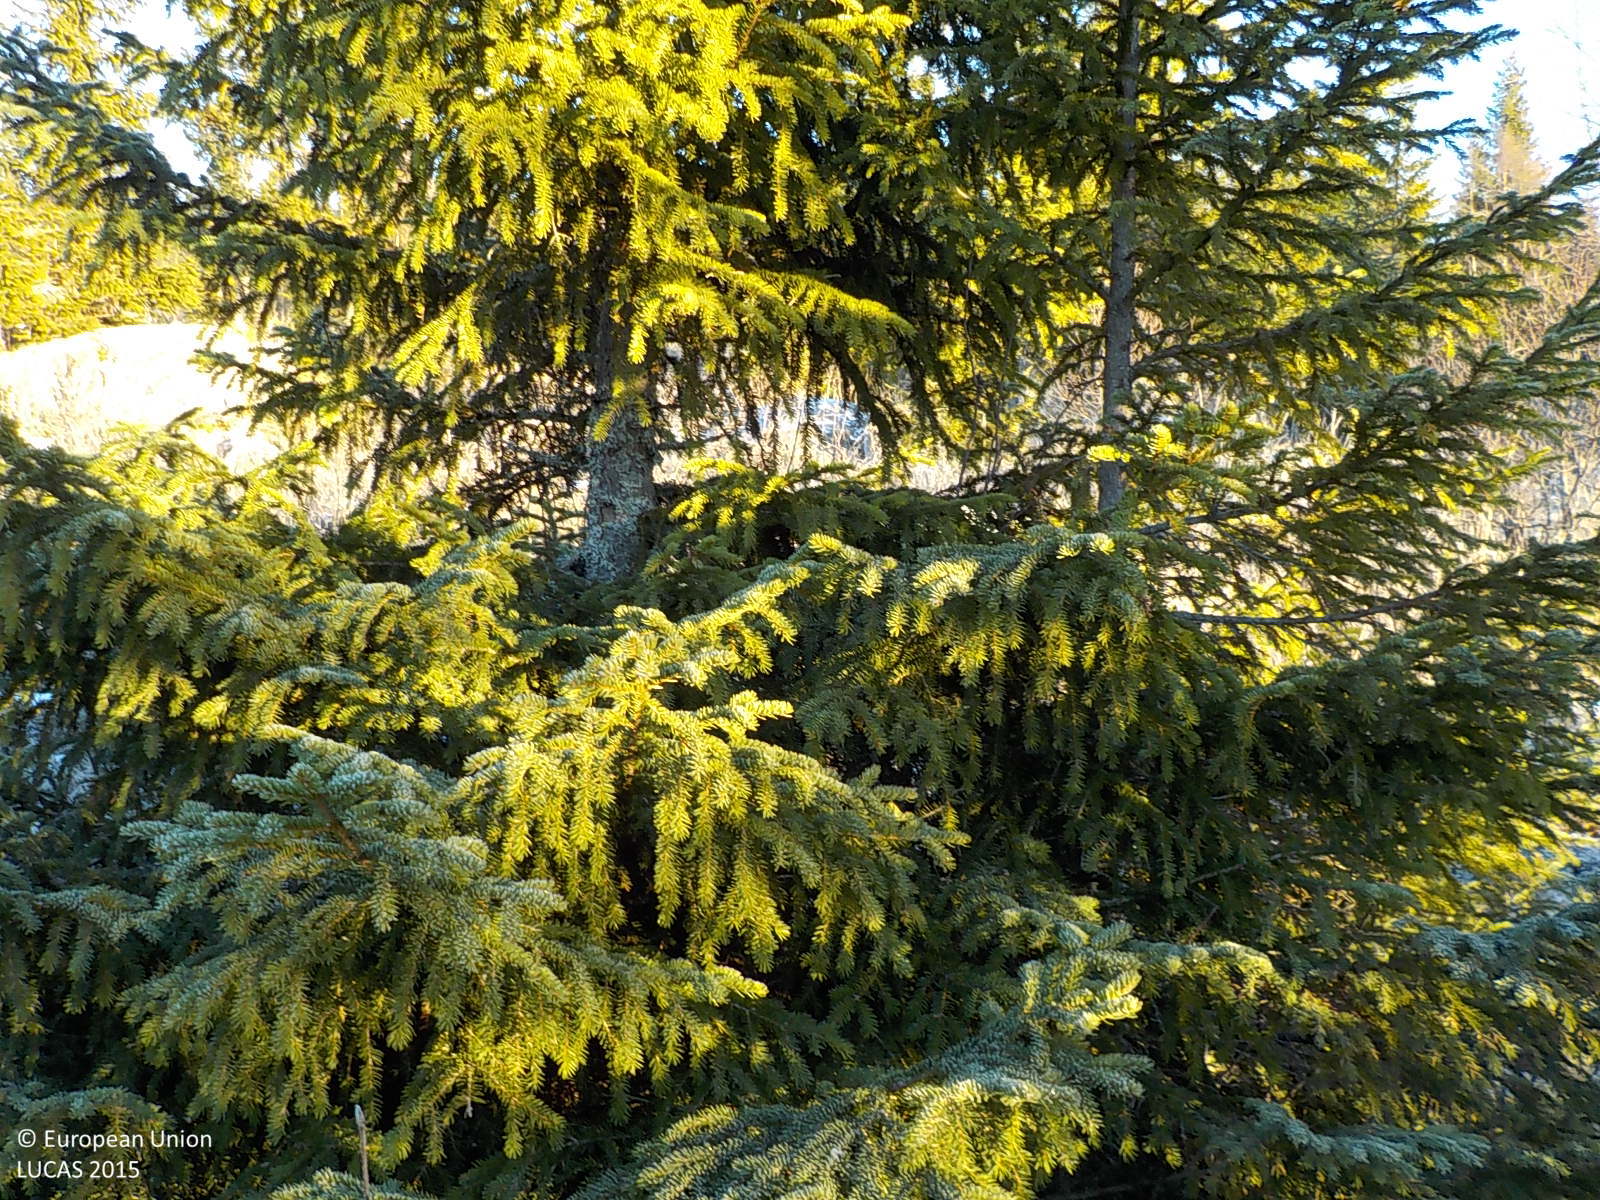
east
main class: Woodland
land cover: Spruce dominated coniferous woodland
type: boreal forest
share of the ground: 50 - 75 %
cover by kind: coniferous forest trees 60 %, shrubs 20 %, herbaceous plants 20 %
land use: Forestry
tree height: < 5 m
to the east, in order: Spruce dominated coniferous woodland; Pine dominated mixed woodland; Paved roads, cycling and walking lanes
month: November
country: SE
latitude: 63.1280
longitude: 18.2870
